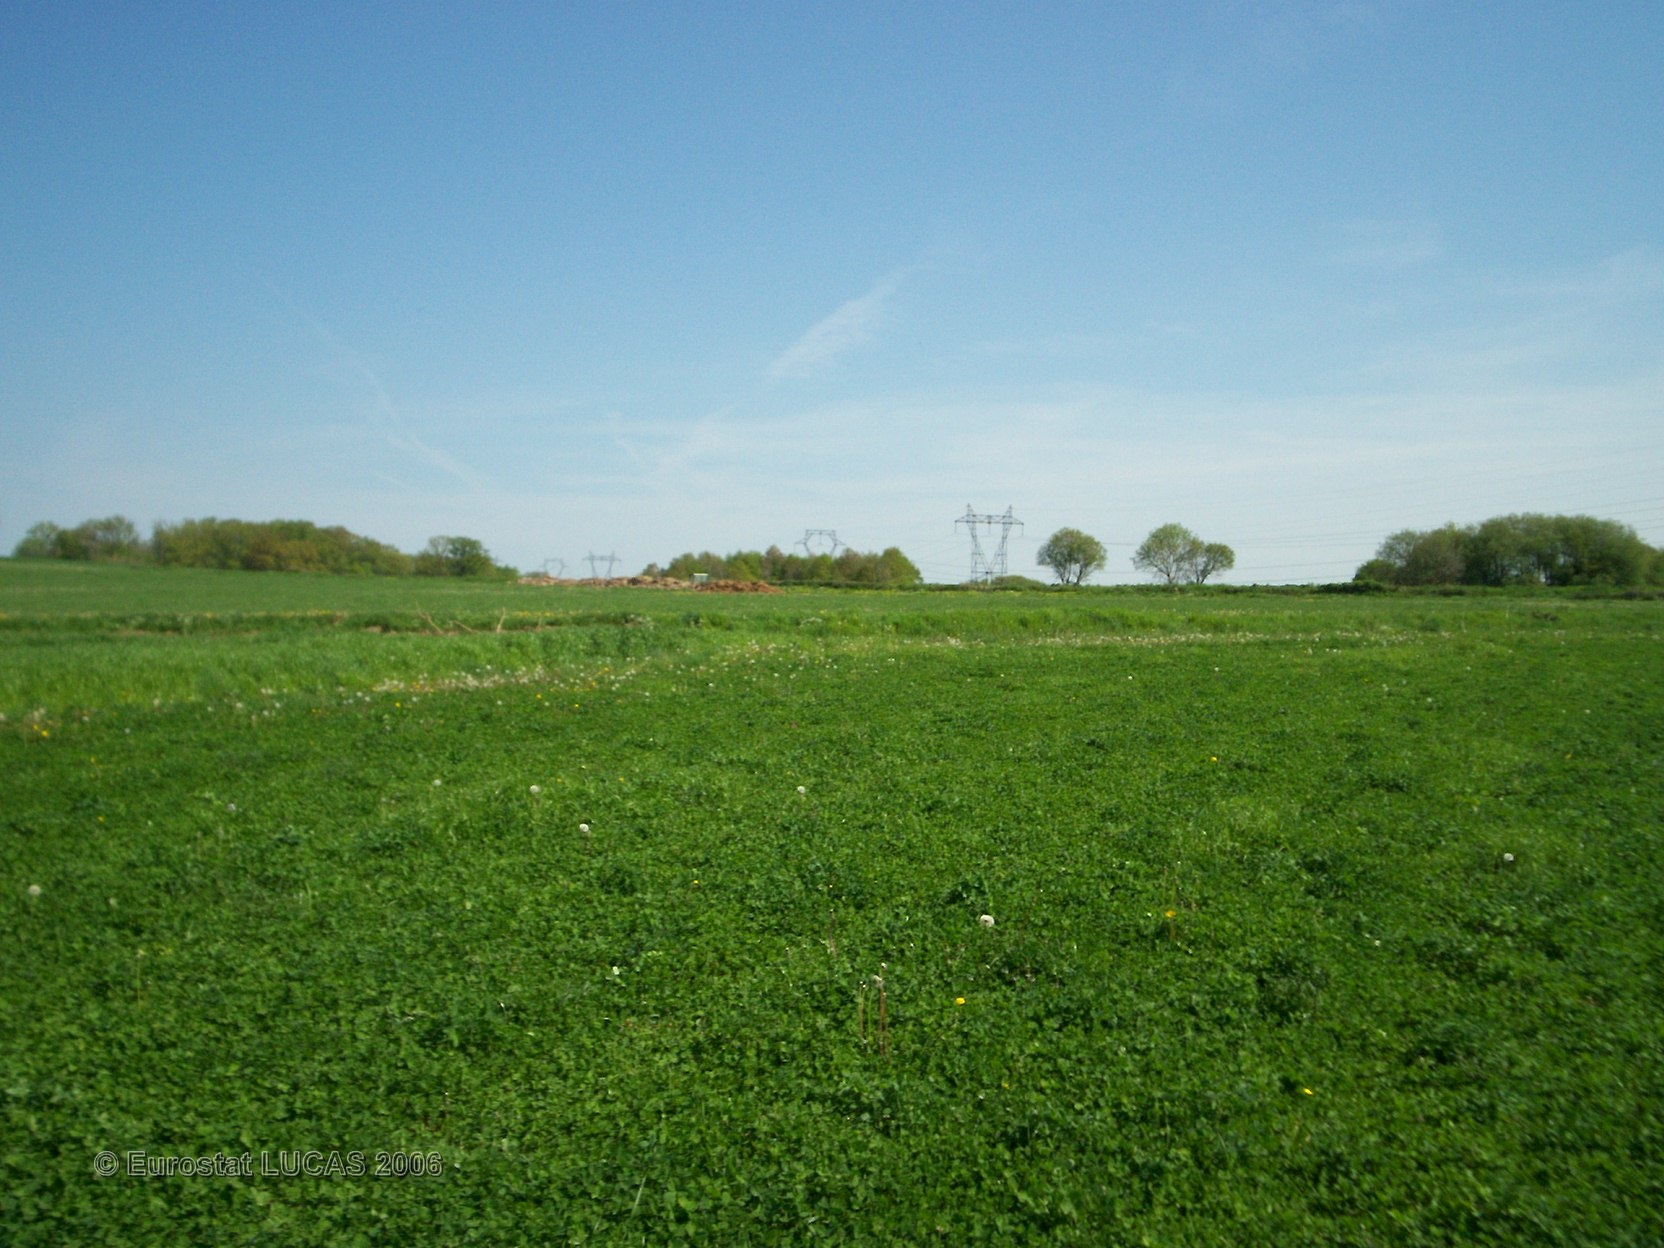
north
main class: Cropland
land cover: Clovers
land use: Agriculture (excluding fallow land and kitchen gardens)
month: May
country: FR
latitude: 46.3490
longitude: 1.6357
